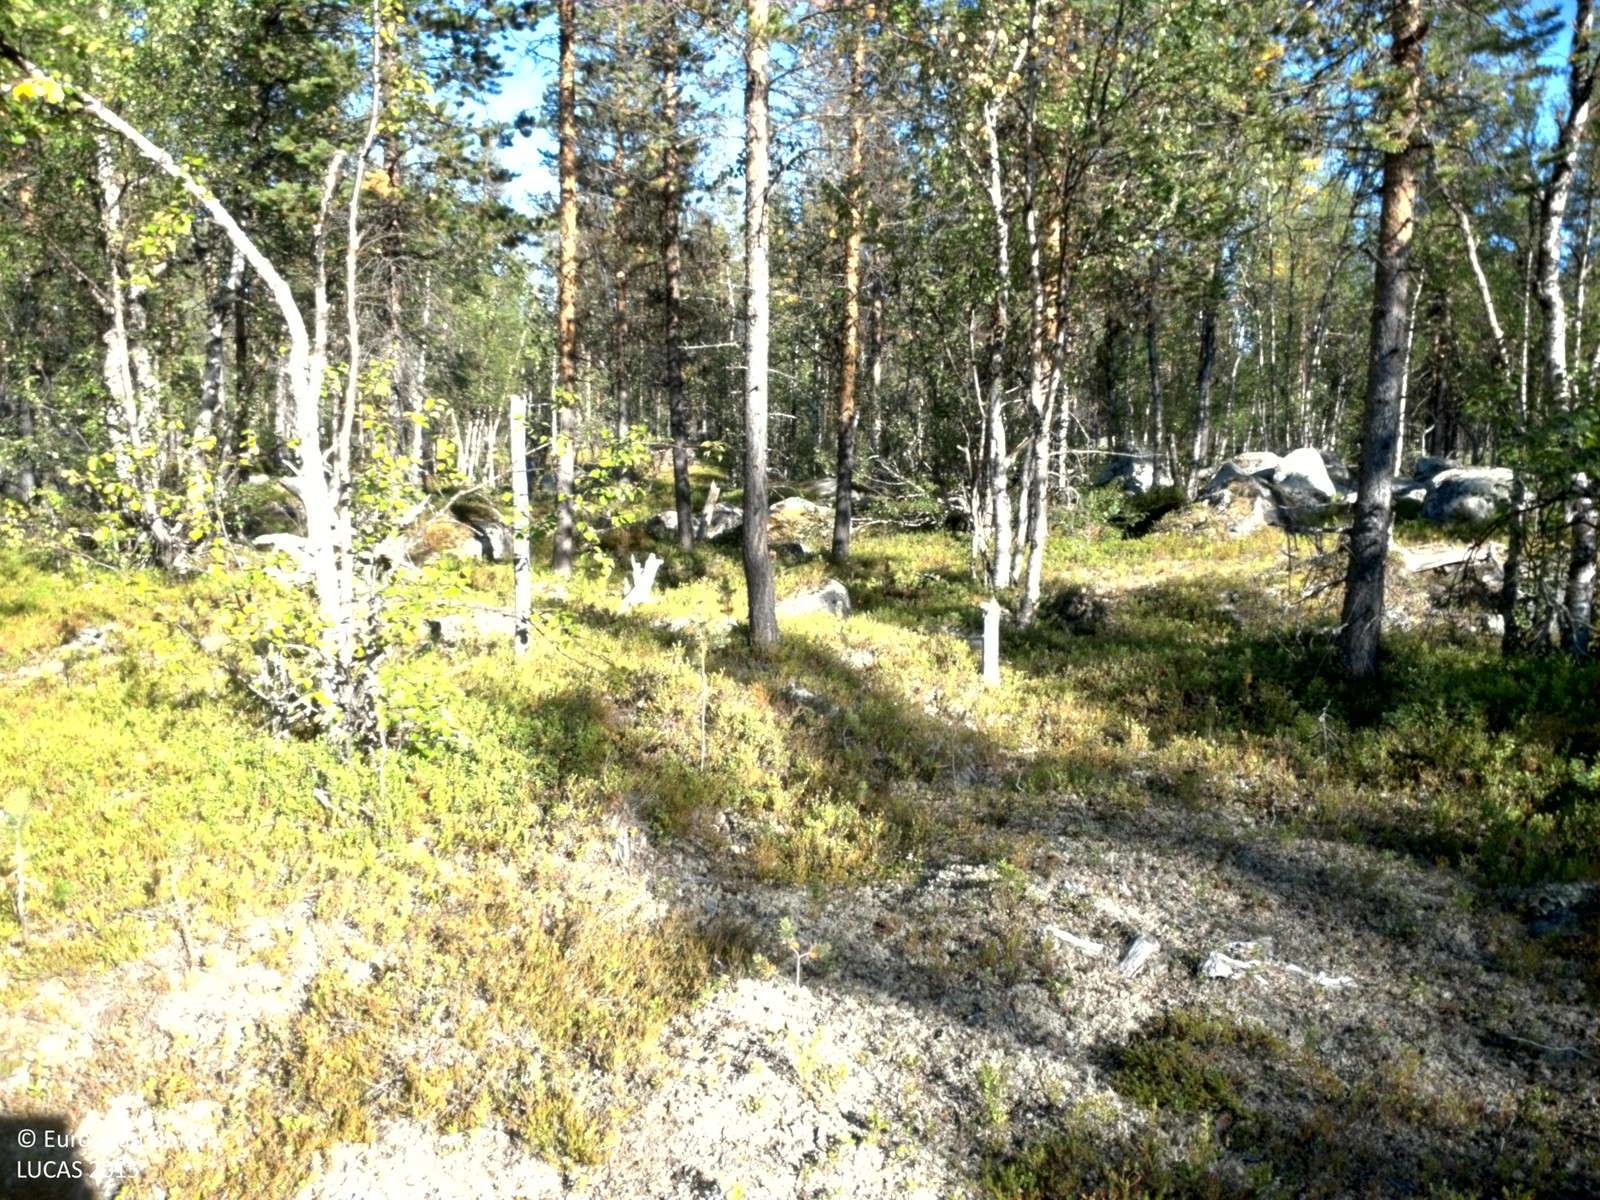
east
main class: Woodland
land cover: Pine dominated mixed woodland
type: boreal forest
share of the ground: 25 - 50 %
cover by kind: shrubs 50 %, coniferous forest trees 15 %, lichens and mosses 15 %, broadleaved forest trees 10 %, consolidated bare surface 10 %
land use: Forestry
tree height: > 5 m
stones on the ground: 25 - 50 %
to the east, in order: Pine dominated mixed woodland; Pine dominated coniferous woodland; Grassland with sparse tree/shrub cover; Inland marshes; Pine dominated coniferous woodland
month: August
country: SE
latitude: 66.6957
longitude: 18.9423
